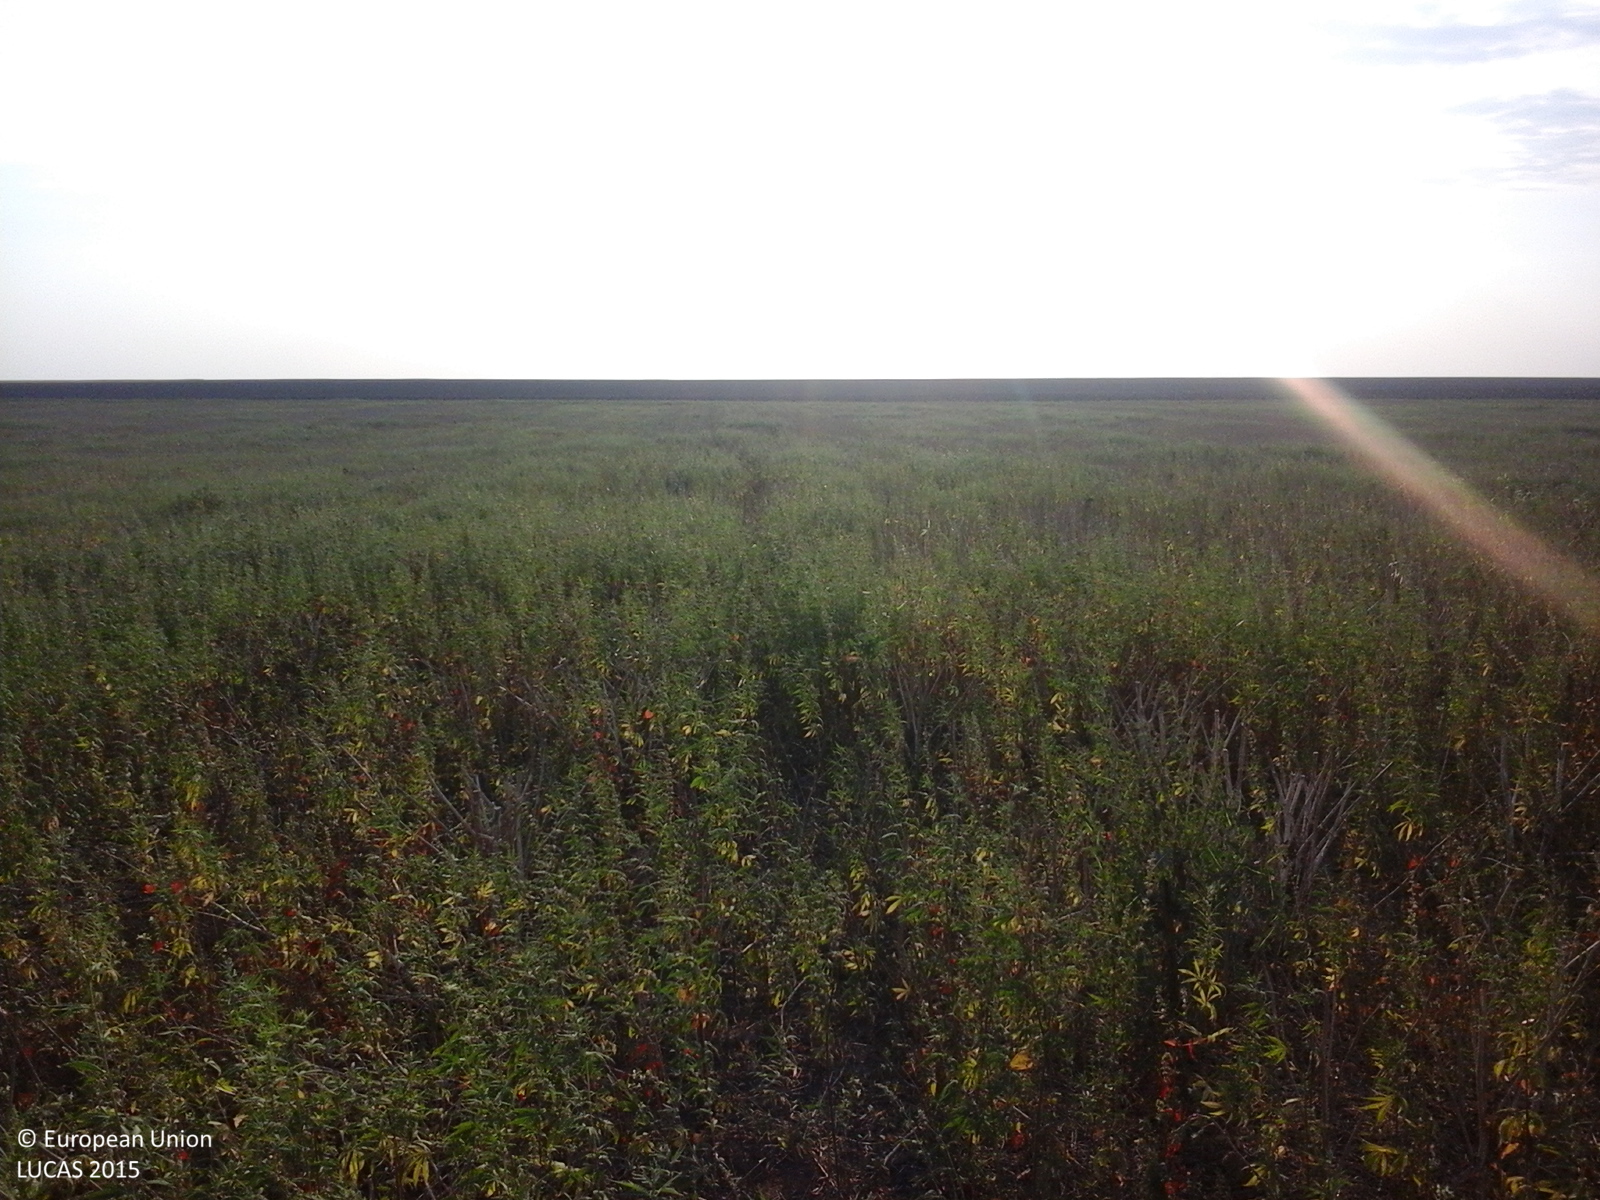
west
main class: Cropland
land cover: Rape and turnip rape
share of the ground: > 75 %
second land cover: Spontaneously vegetated surfaces
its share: 50 - 75 %
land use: Agriculture (excluding fallow land and kitchen gardens)
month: August
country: RO
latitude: 44.0451
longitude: 28.1409
